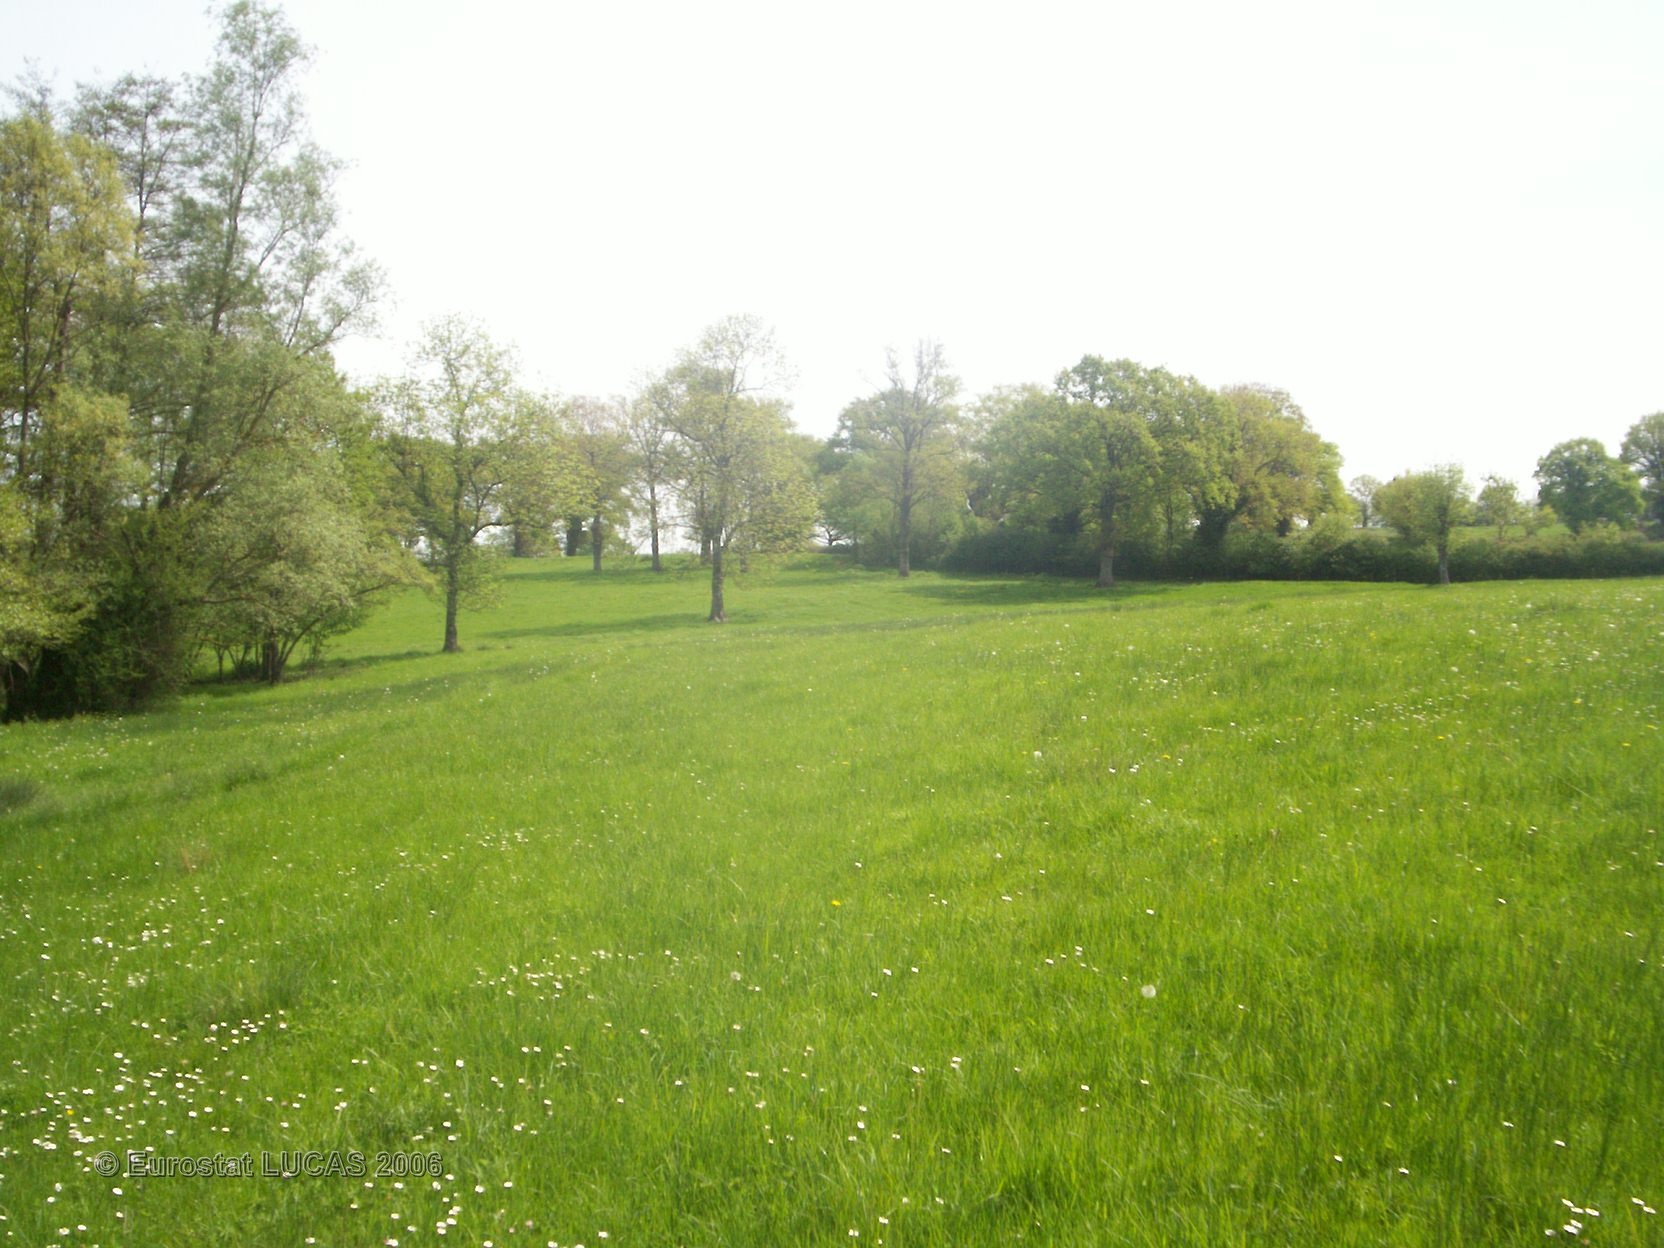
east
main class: Grassland
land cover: Grassland with sparse tree/shrub cover
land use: Agriculture (excluding fallow land and kitchen gardens)
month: May
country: FR
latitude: 46.5276
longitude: 3.1271
